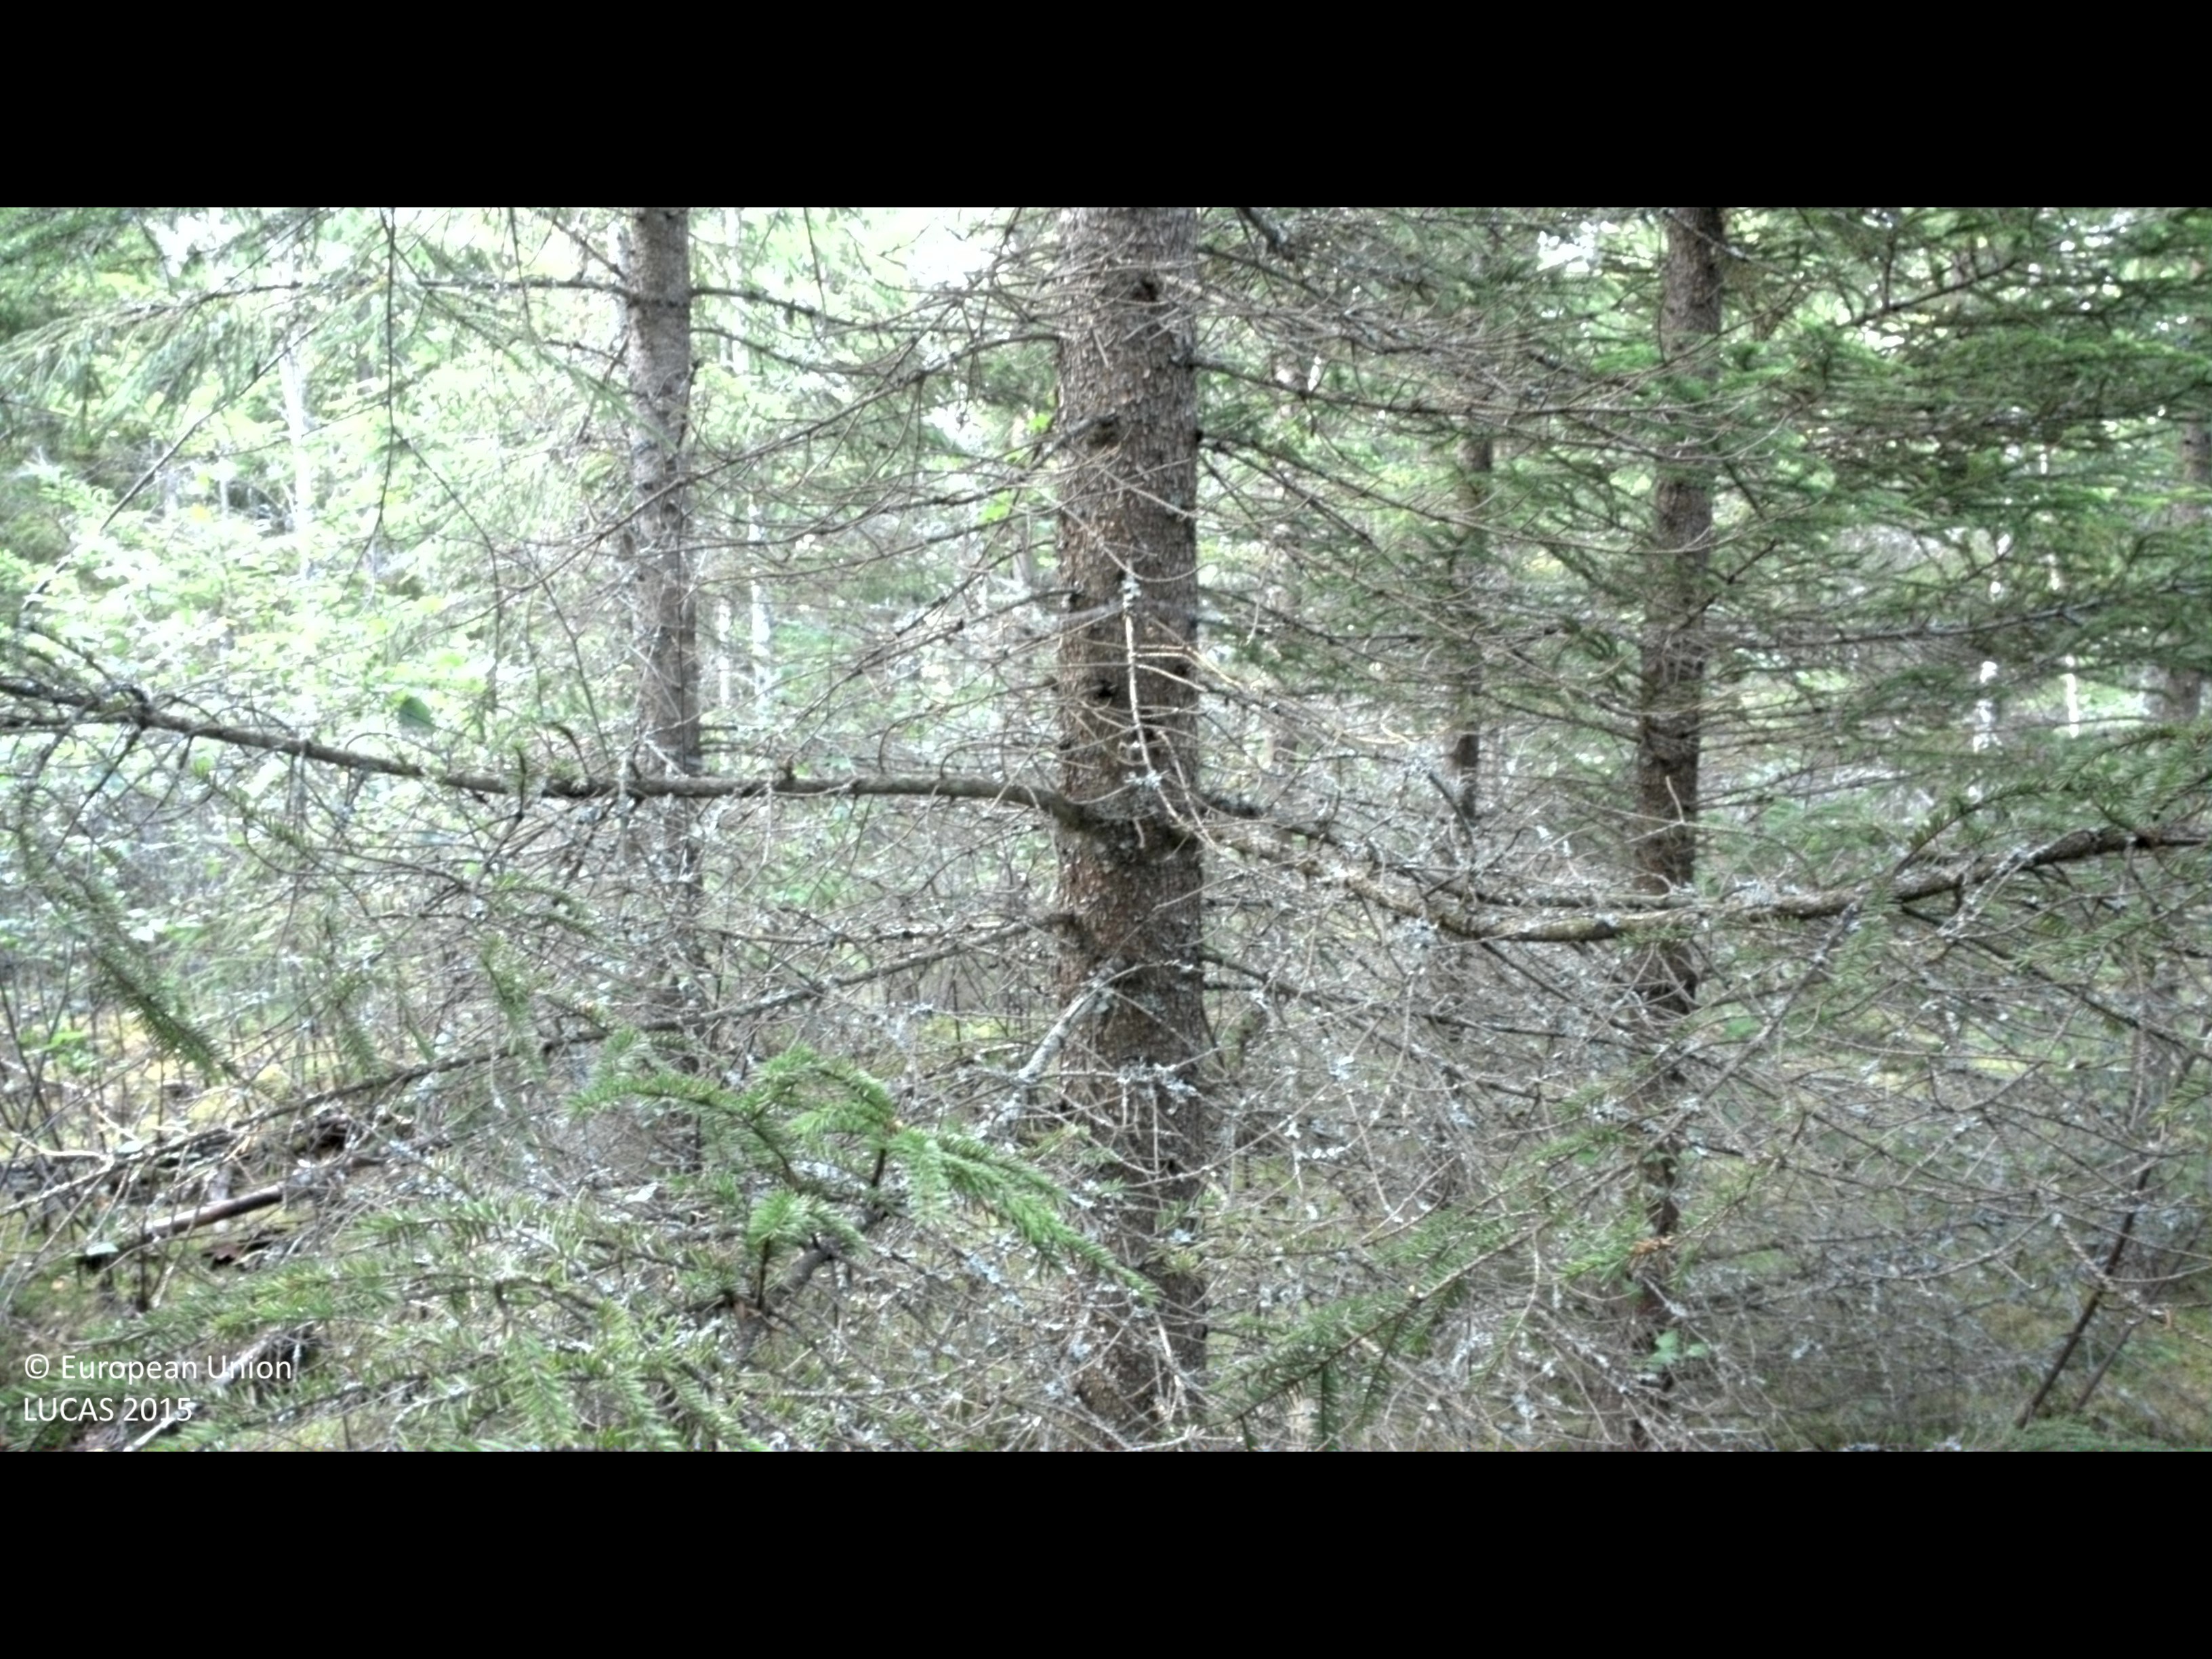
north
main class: Woodland
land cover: Spruce dominated mixed woodland
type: boreal forest
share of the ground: > 75 %
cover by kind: coniferous forest trees 60 %, broadleaved forest trees 20 %, shrubs 10 %, lichens and mosses 10 %
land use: Forestry
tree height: > 5 m
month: August
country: SE
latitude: 56.6933
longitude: 14.2587
